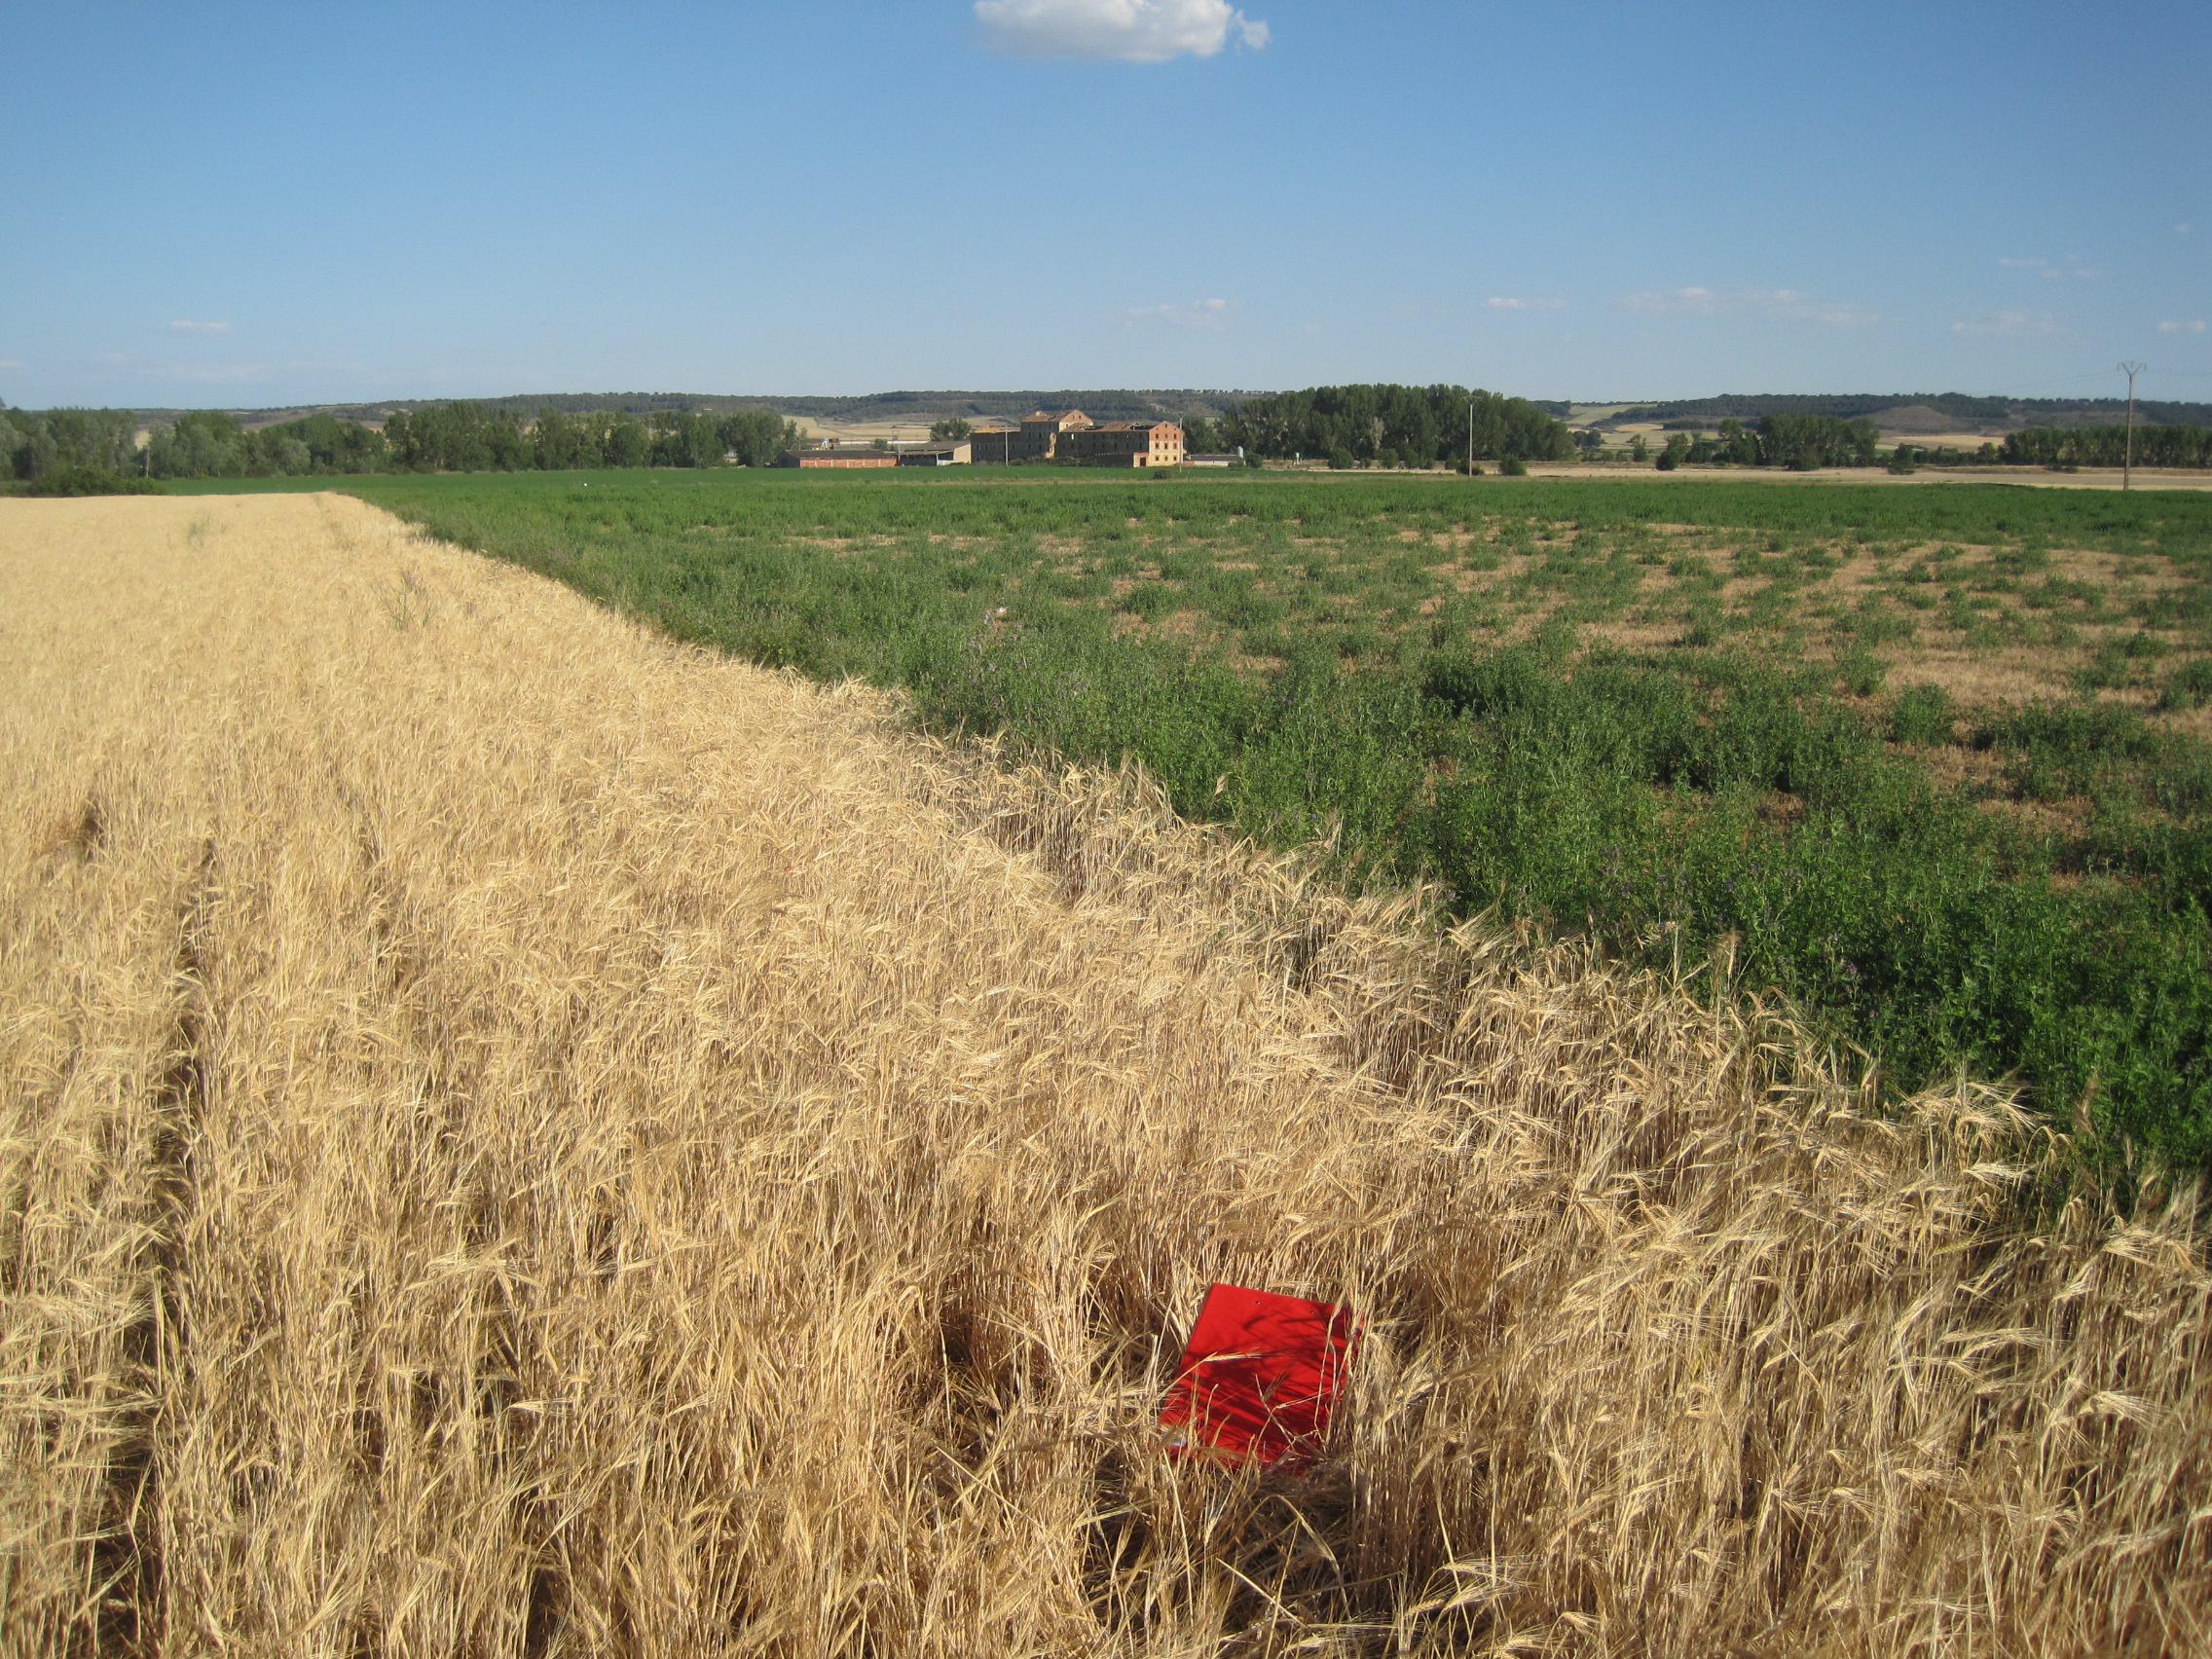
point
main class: Cropland
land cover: Barley
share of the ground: > 75 %
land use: Agriculture (excluding fallow land and kitchen gardens)
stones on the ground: 10 - 25 %
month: June
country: ES
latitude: 41.8203
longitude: -5.1395
